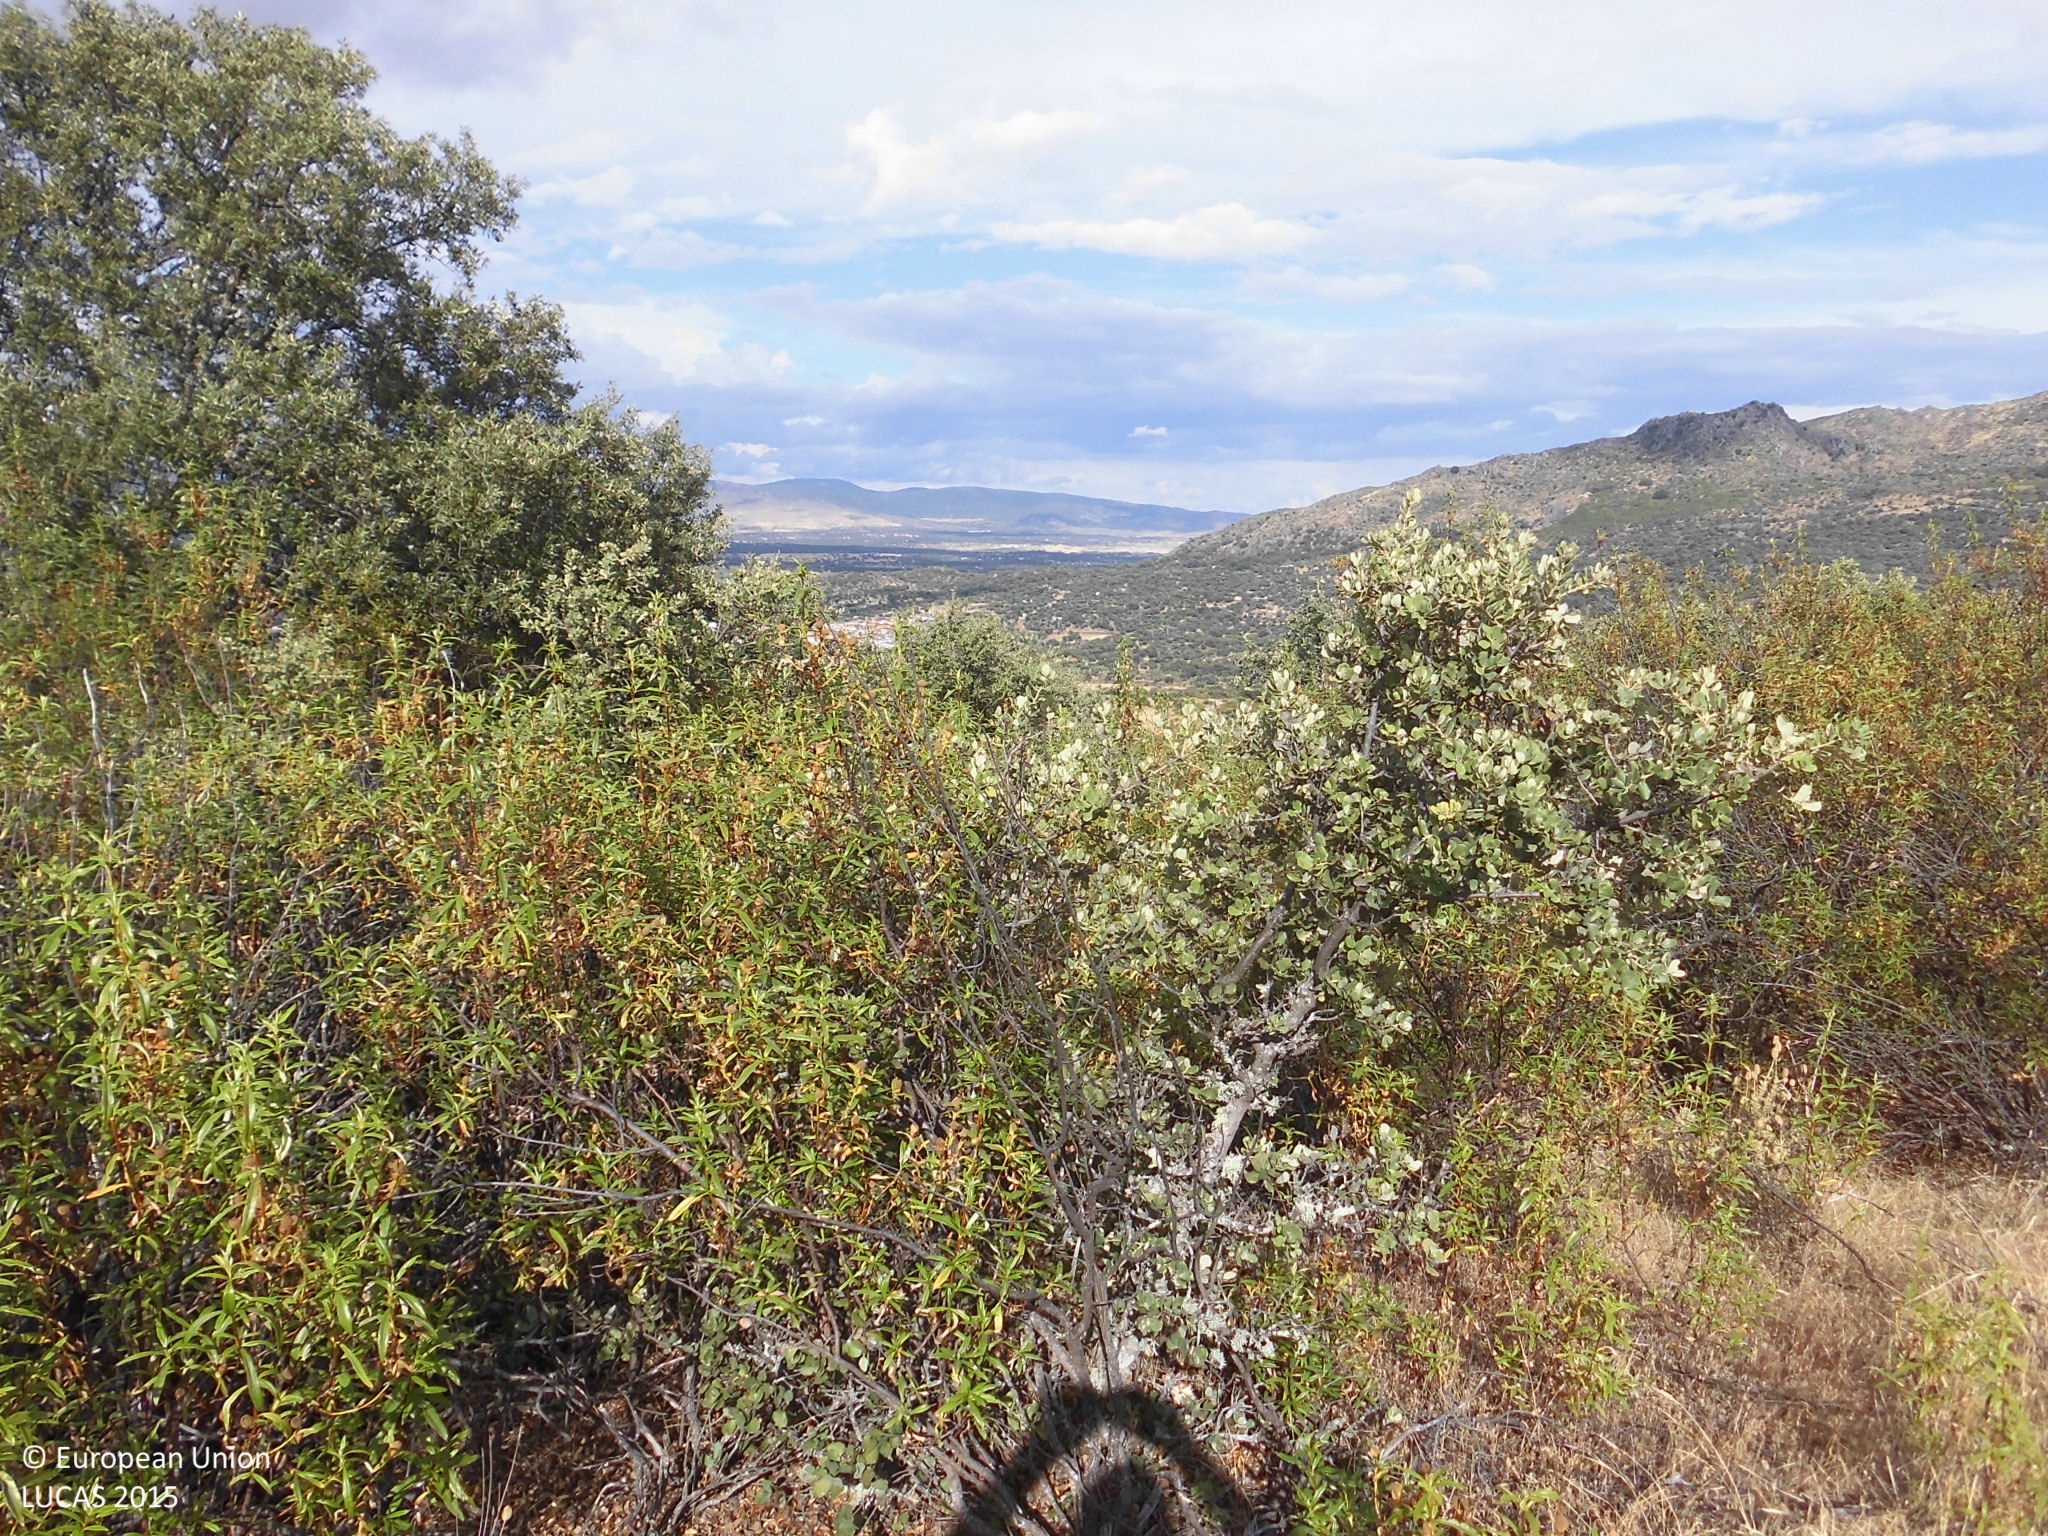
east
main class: Shrubland
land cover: Shrubland with sparse tree cover
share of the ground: 50 - 75 %
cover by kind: shrubs 60 %, herbaceous plants 30 %, broadleaved forest trees 5 %, consolidated bare surface 5 %
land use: Semi-natural and natural areas not in use
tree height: < 5 m
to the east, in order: Shrubland with sparse tree cover
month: June
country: ES
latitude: 39.3346
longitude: -5.8687
